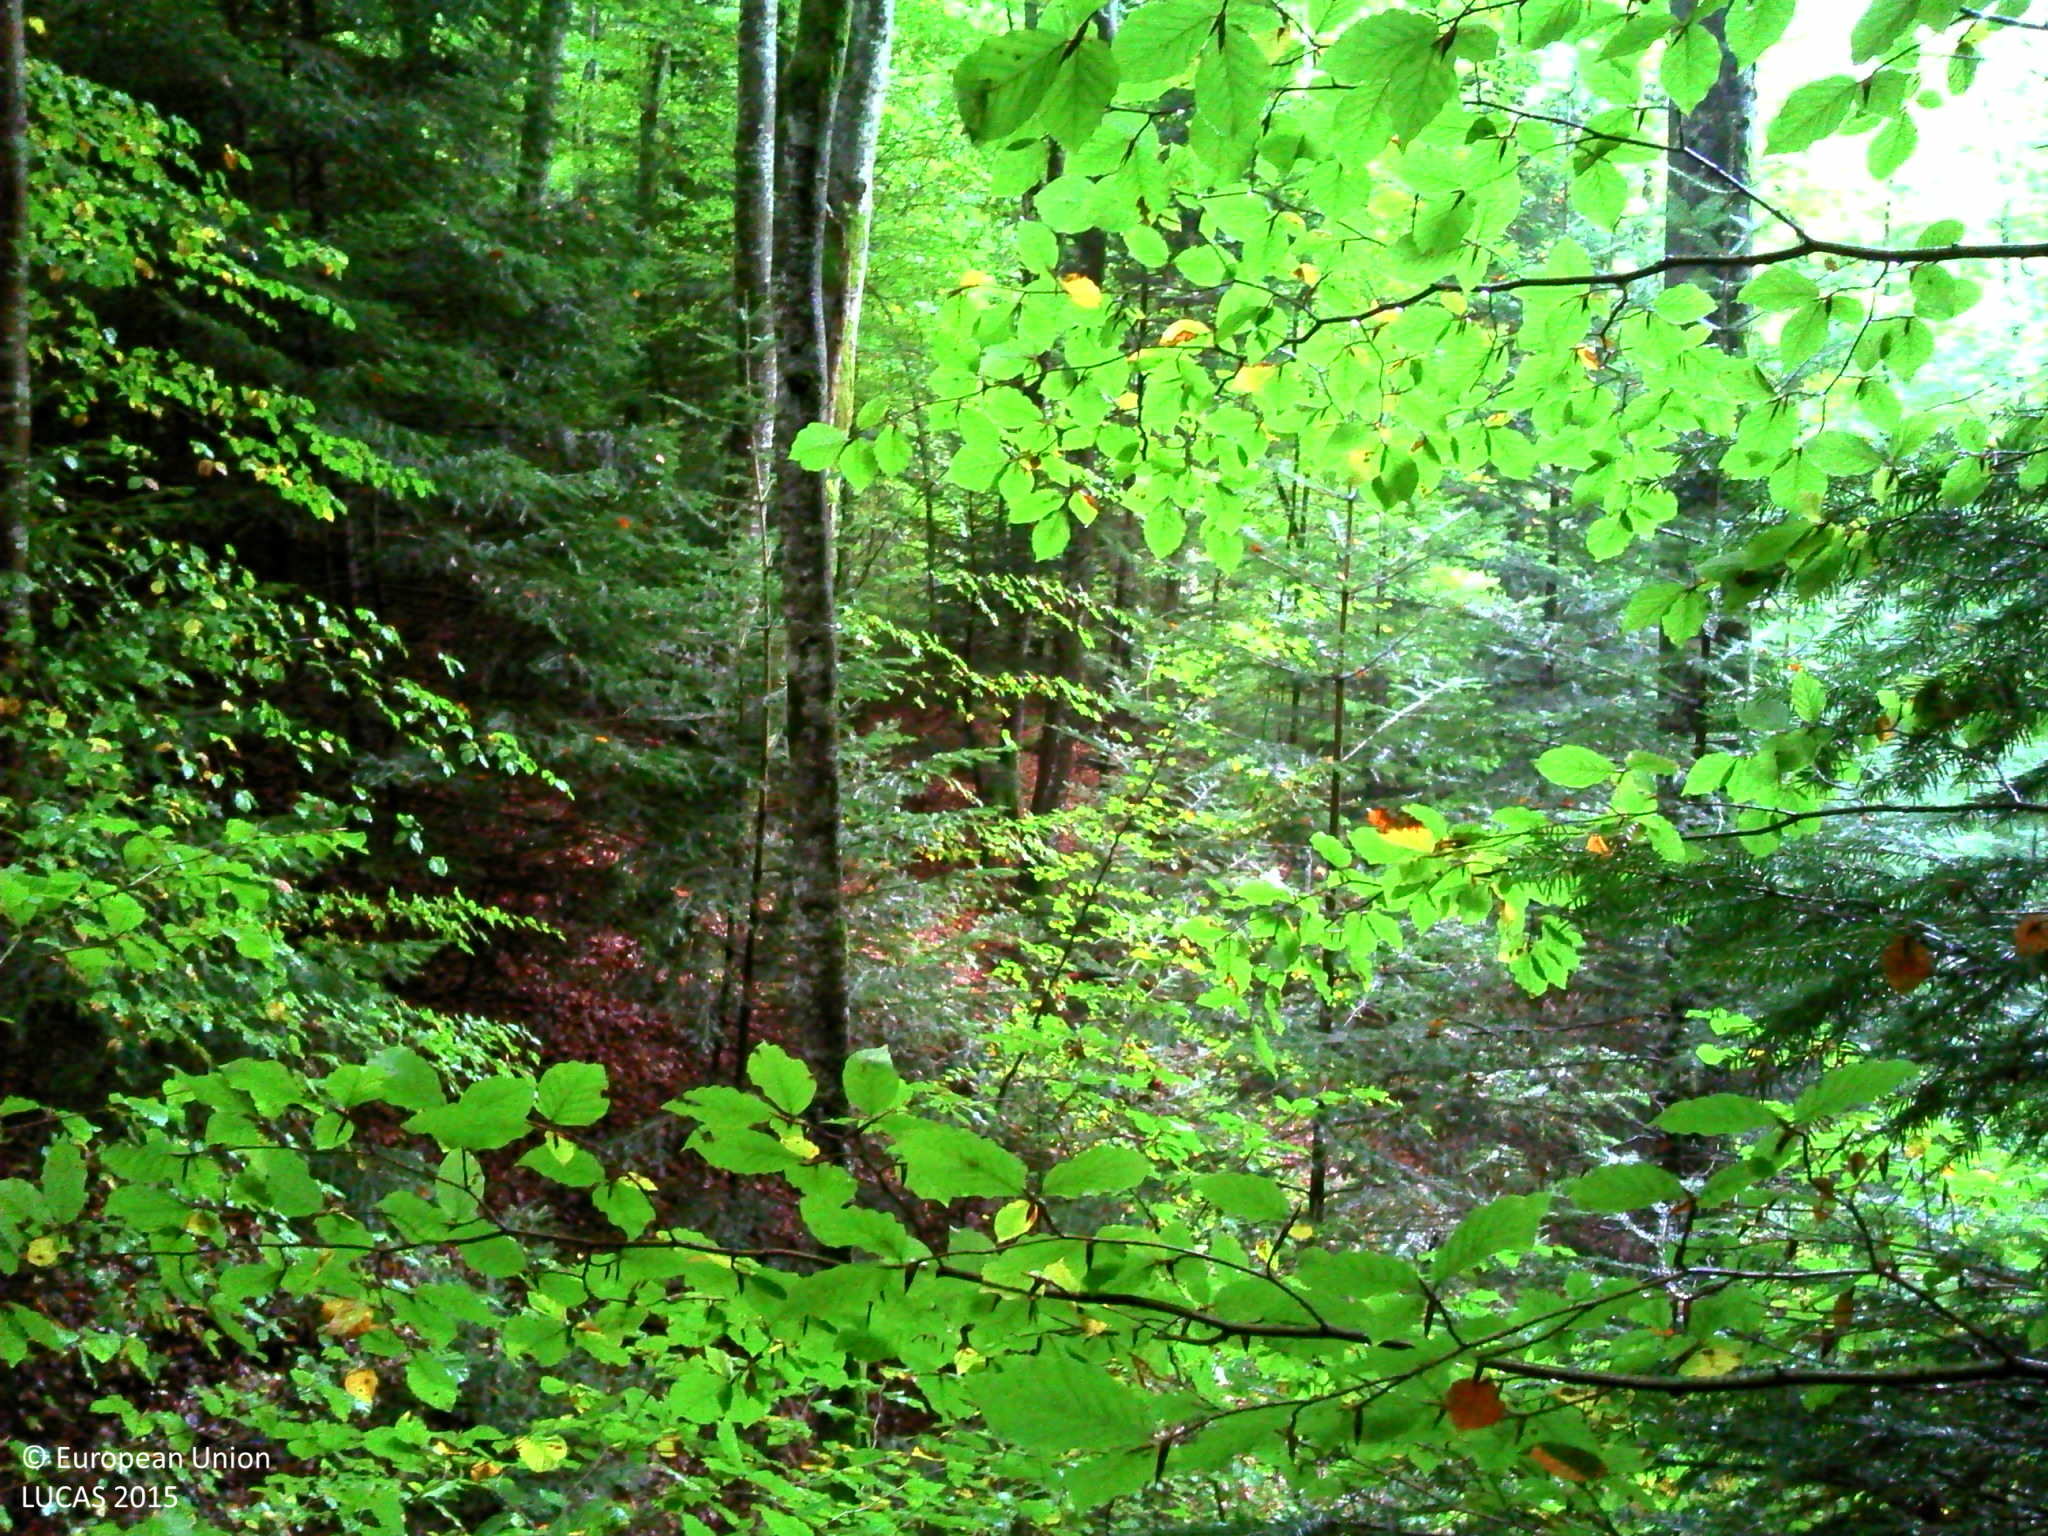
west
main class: Woodland
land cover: Broadleaved woodland
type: mountainous beech forest
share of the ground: > 75 %
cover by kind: broadleaved forest trees 80 %, coniferous forest trees 10 %, herbaceous plants 5 %, lichens and mosses 5 %
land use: Forestry
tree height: > 5 m
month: October
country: FR
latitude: 45.9108
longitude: 3.6712
